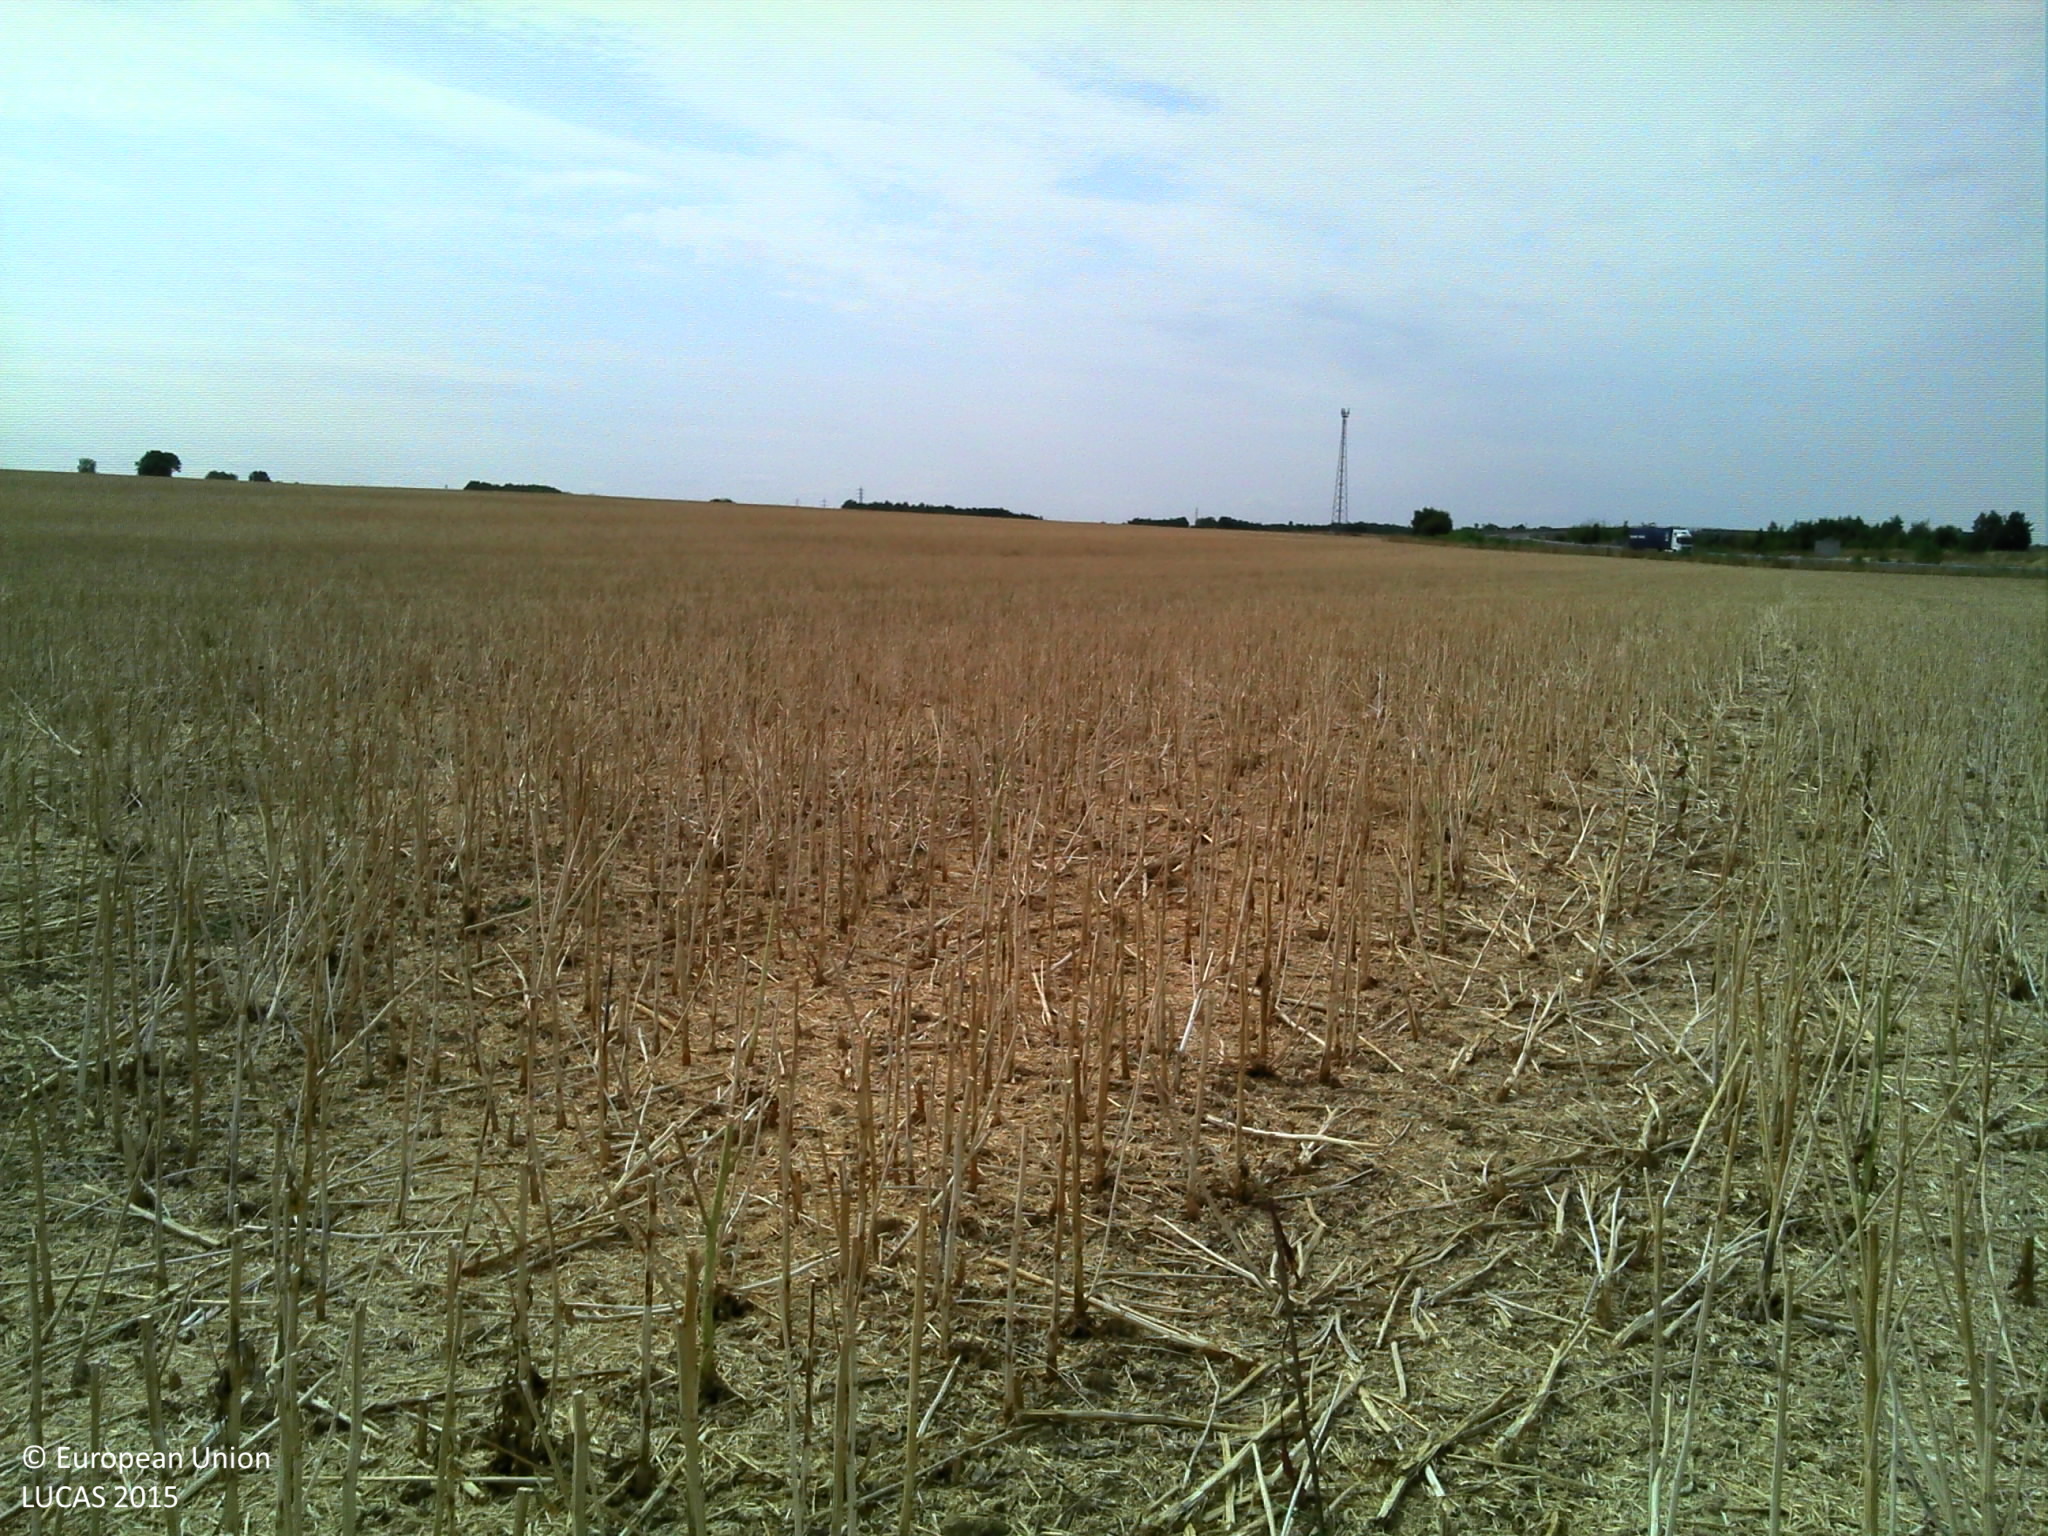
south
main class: Cropland
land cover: Rape and turnip rape
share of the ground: > 75 %
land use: Agriculture (excluding fallow land and kitchen gardens)
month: July
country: FR
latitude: 48.0620
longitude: 3.1095
